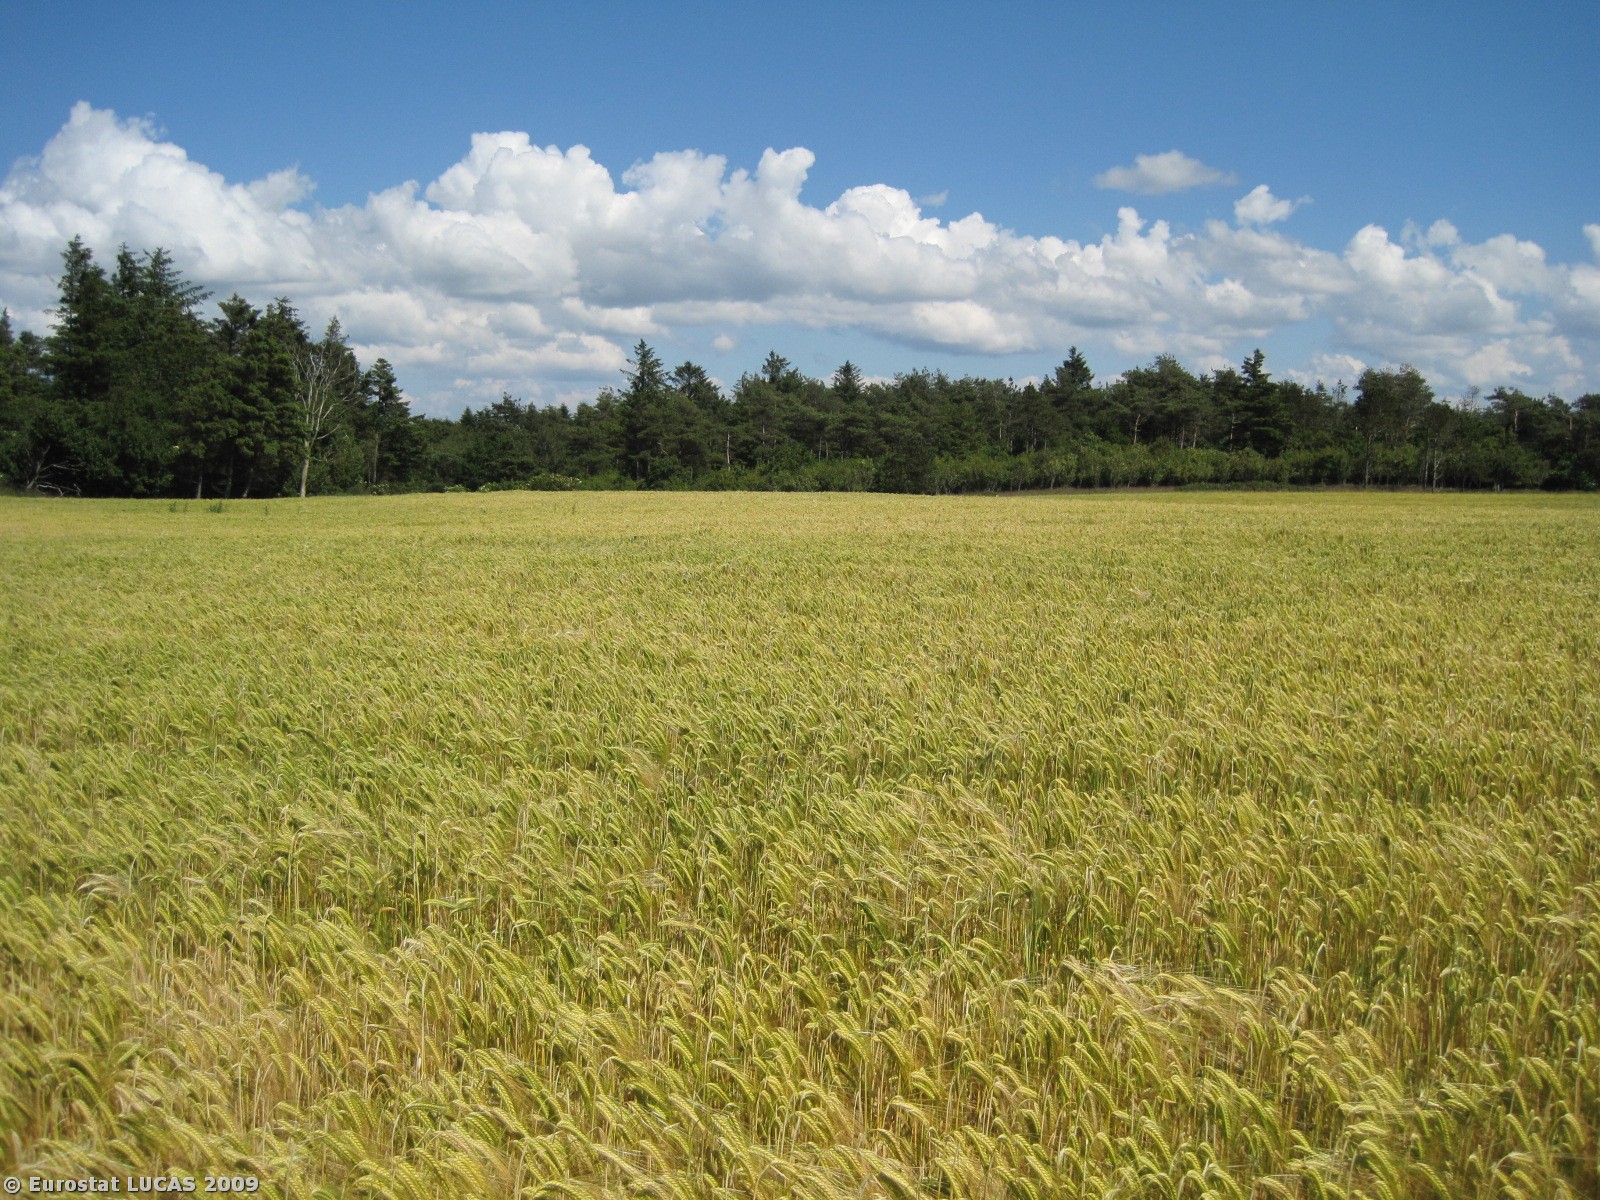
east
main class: Cropland
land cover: Barley
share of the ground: > 75 %
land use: Agriculture (excluding fallow land and kitchen gardens)
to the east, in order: Barley; Grass margins; Mixed woodland
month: June
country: DK
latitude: 56.6131
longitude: 8.7470
